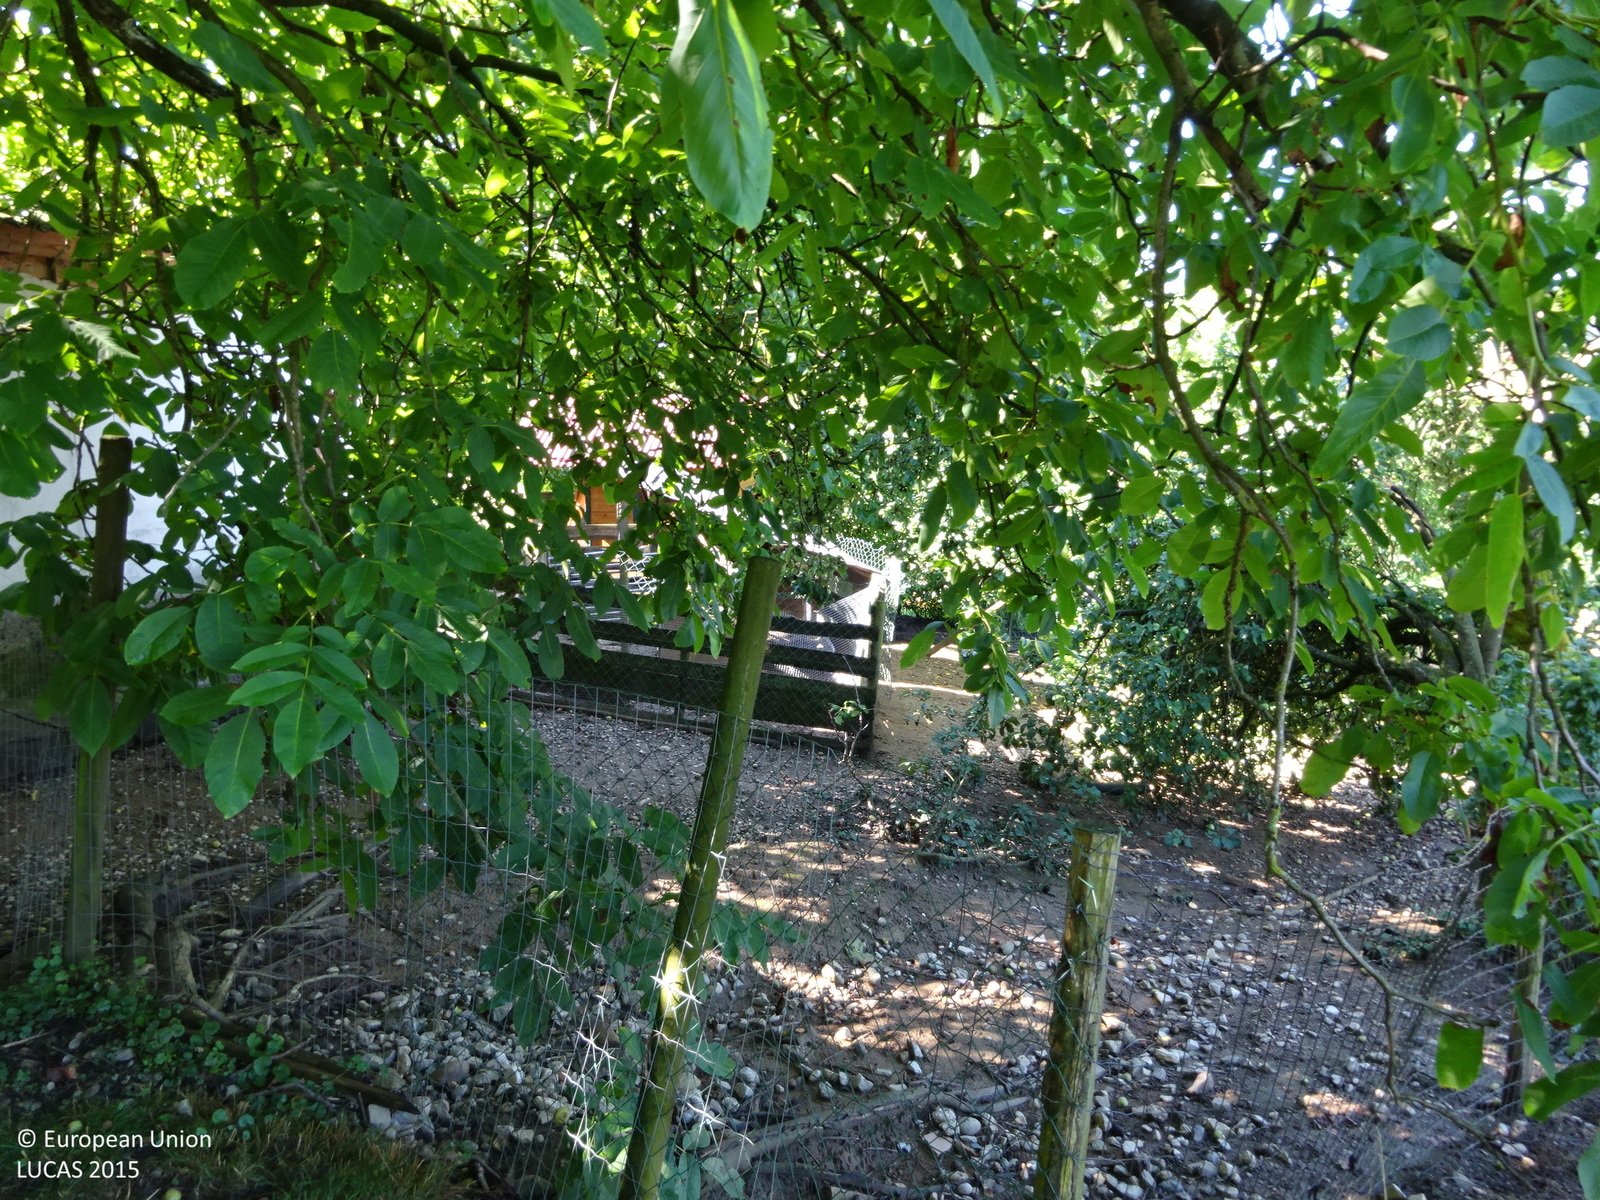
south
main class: Cropland
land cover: Nuts trees
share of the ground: 10 - 25 %
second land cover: Grassland without tree/shrub cover
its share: > 75 %
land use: Agriculture (excluding fallow land and kitchen gardens)
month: July
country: AT
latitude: 46.9228
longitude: 15.3179
